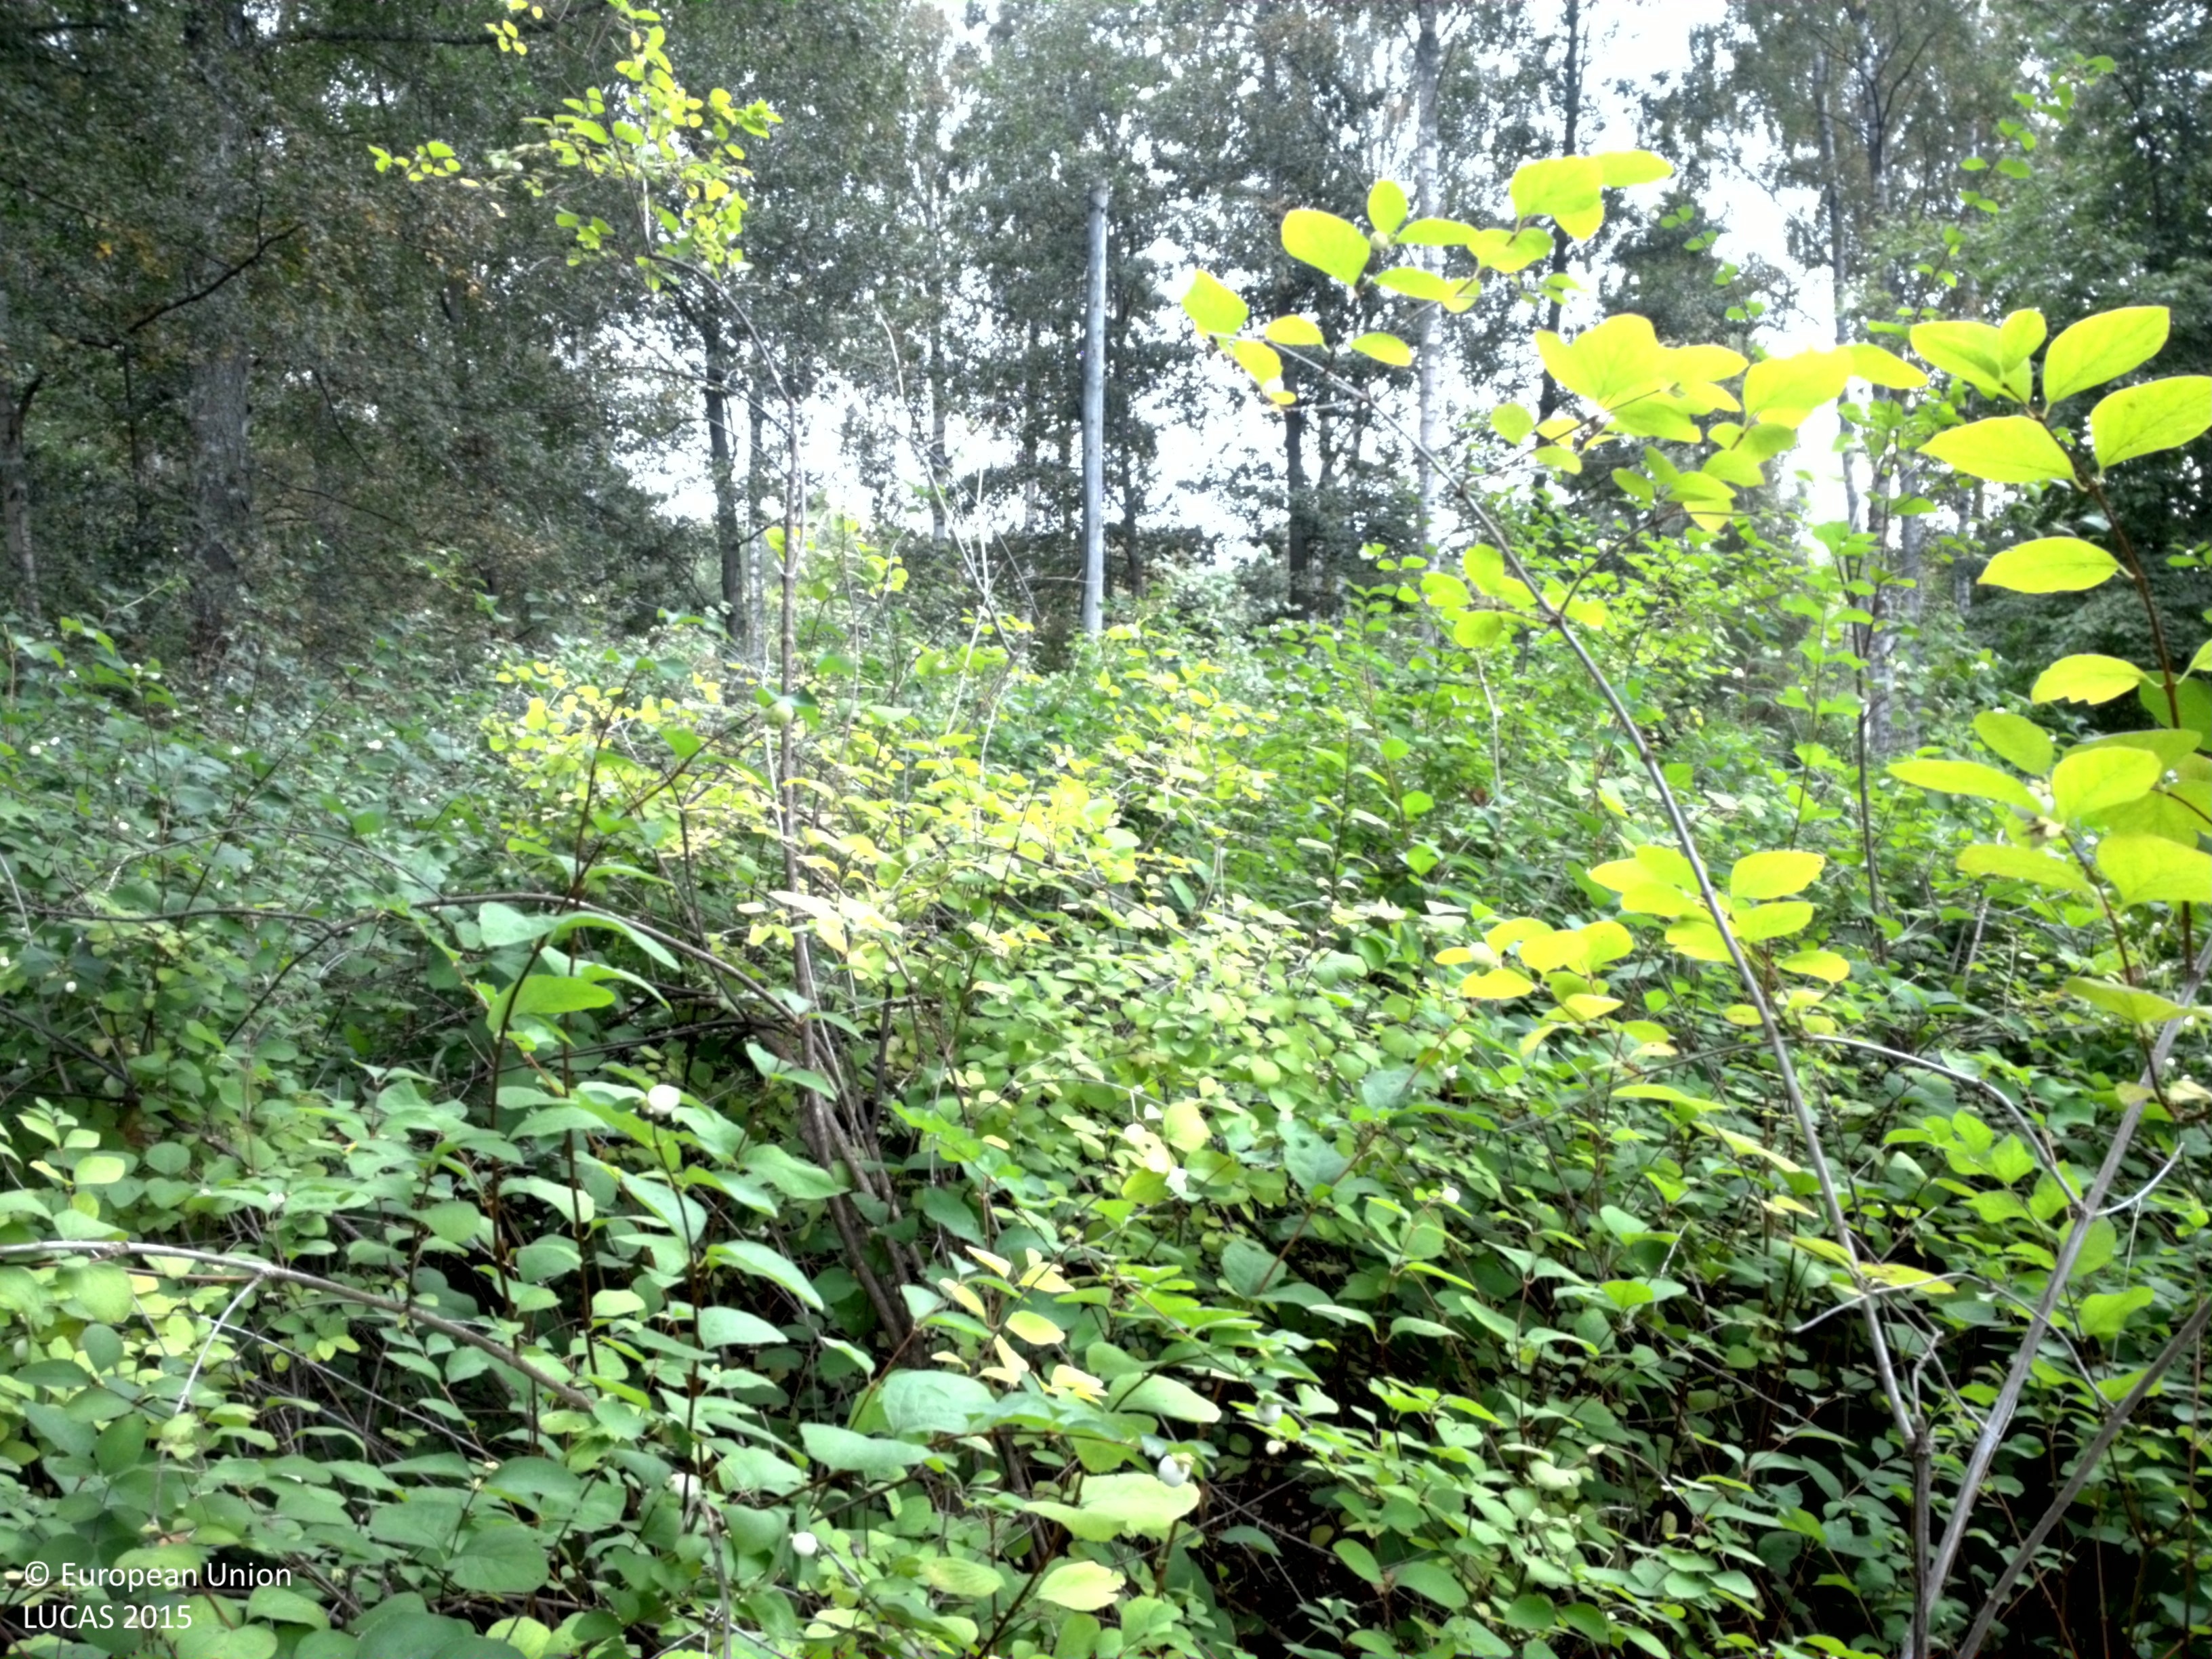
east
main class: Woodland
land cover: Broadleaved woodland
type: boreal forest
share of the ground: 50 - 75 %
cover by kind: broadleaved forest trees 65 %, shrubs 20 %, coniferous forest trees 10 %, herbaceous plants 5 %
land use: Amenities, museums, leisure
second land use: Residential
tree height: > 5 m
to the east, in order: Broadleaved woodland; Ditches and canals; Broadleaved woodland; Artificial constructions in urban areas
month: September
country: SE
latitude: 59.2376
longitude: 18.4674
